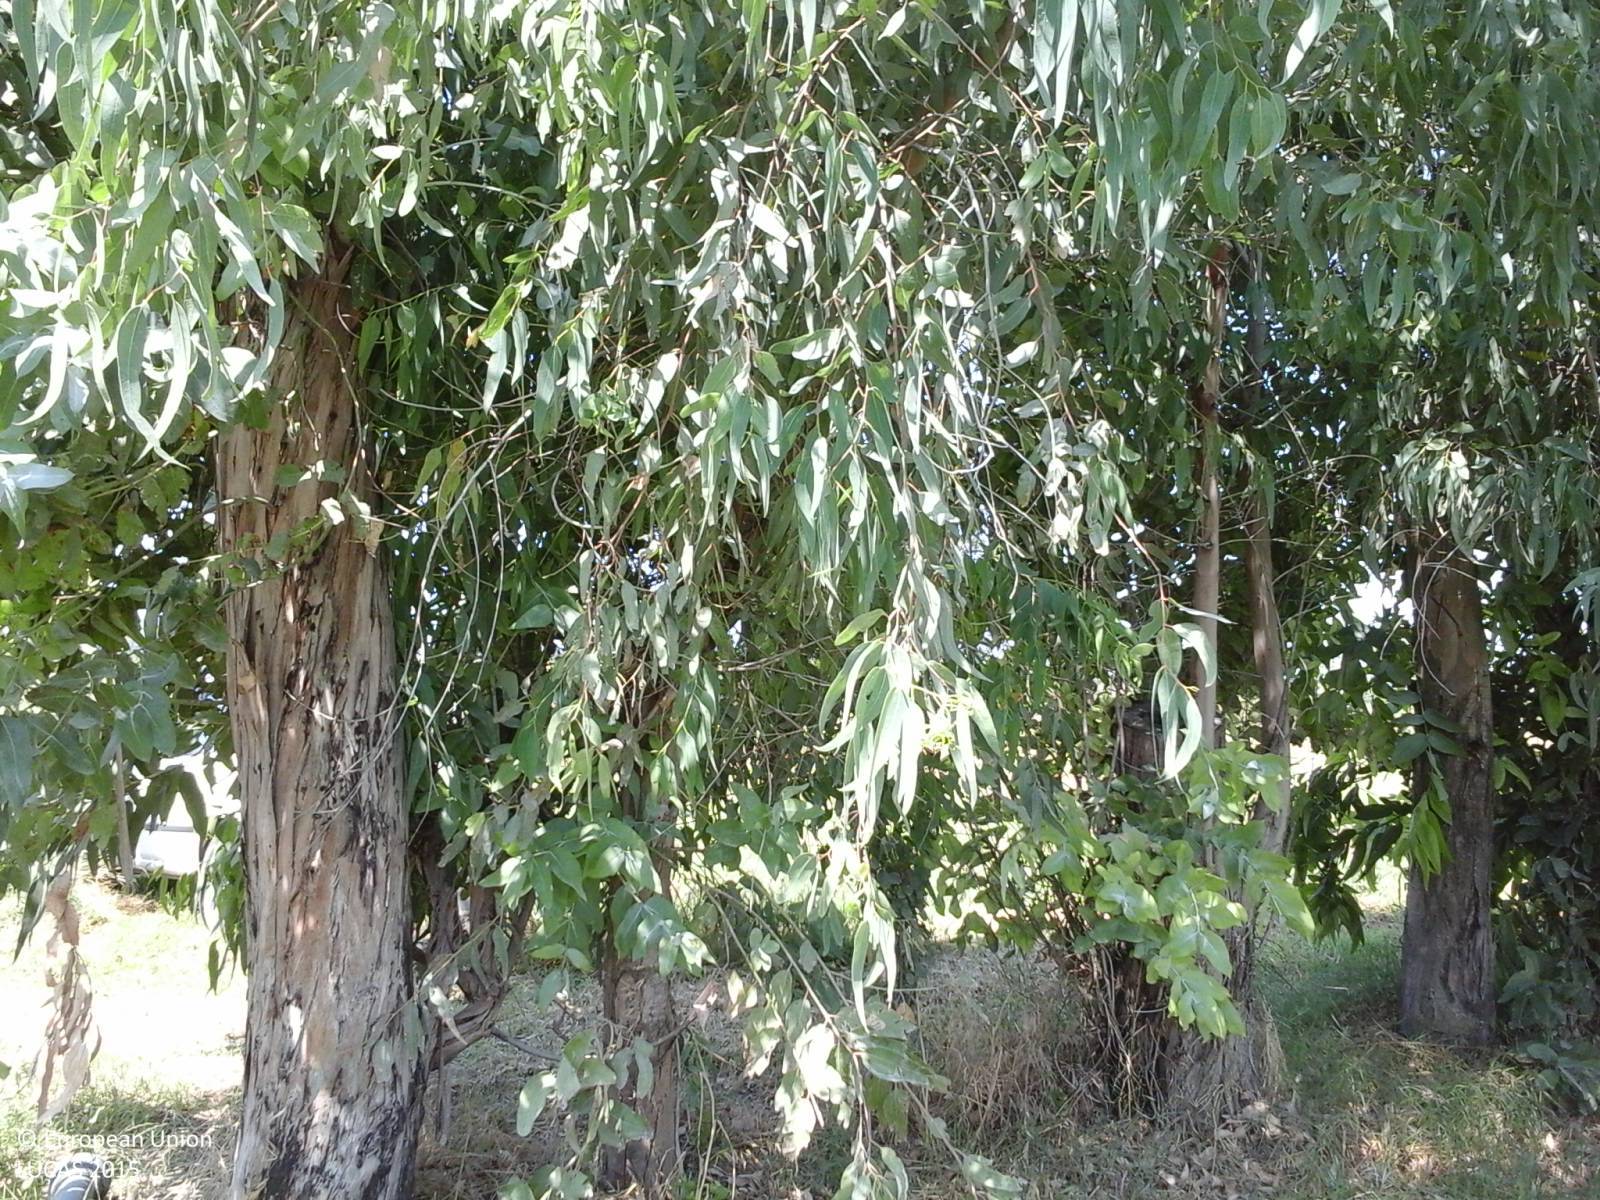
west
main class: Woodland
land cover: Broadleaved woodland
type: non-riverine alder, birch or aspen forest
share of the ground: > 75 %
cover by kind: broadleaved forest trees 70 %, herbaceous plants 30 %
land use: Amenities, museums, leisure
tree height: < 5 m
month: July
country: IT
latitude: 41.0944
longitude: 13.9247
